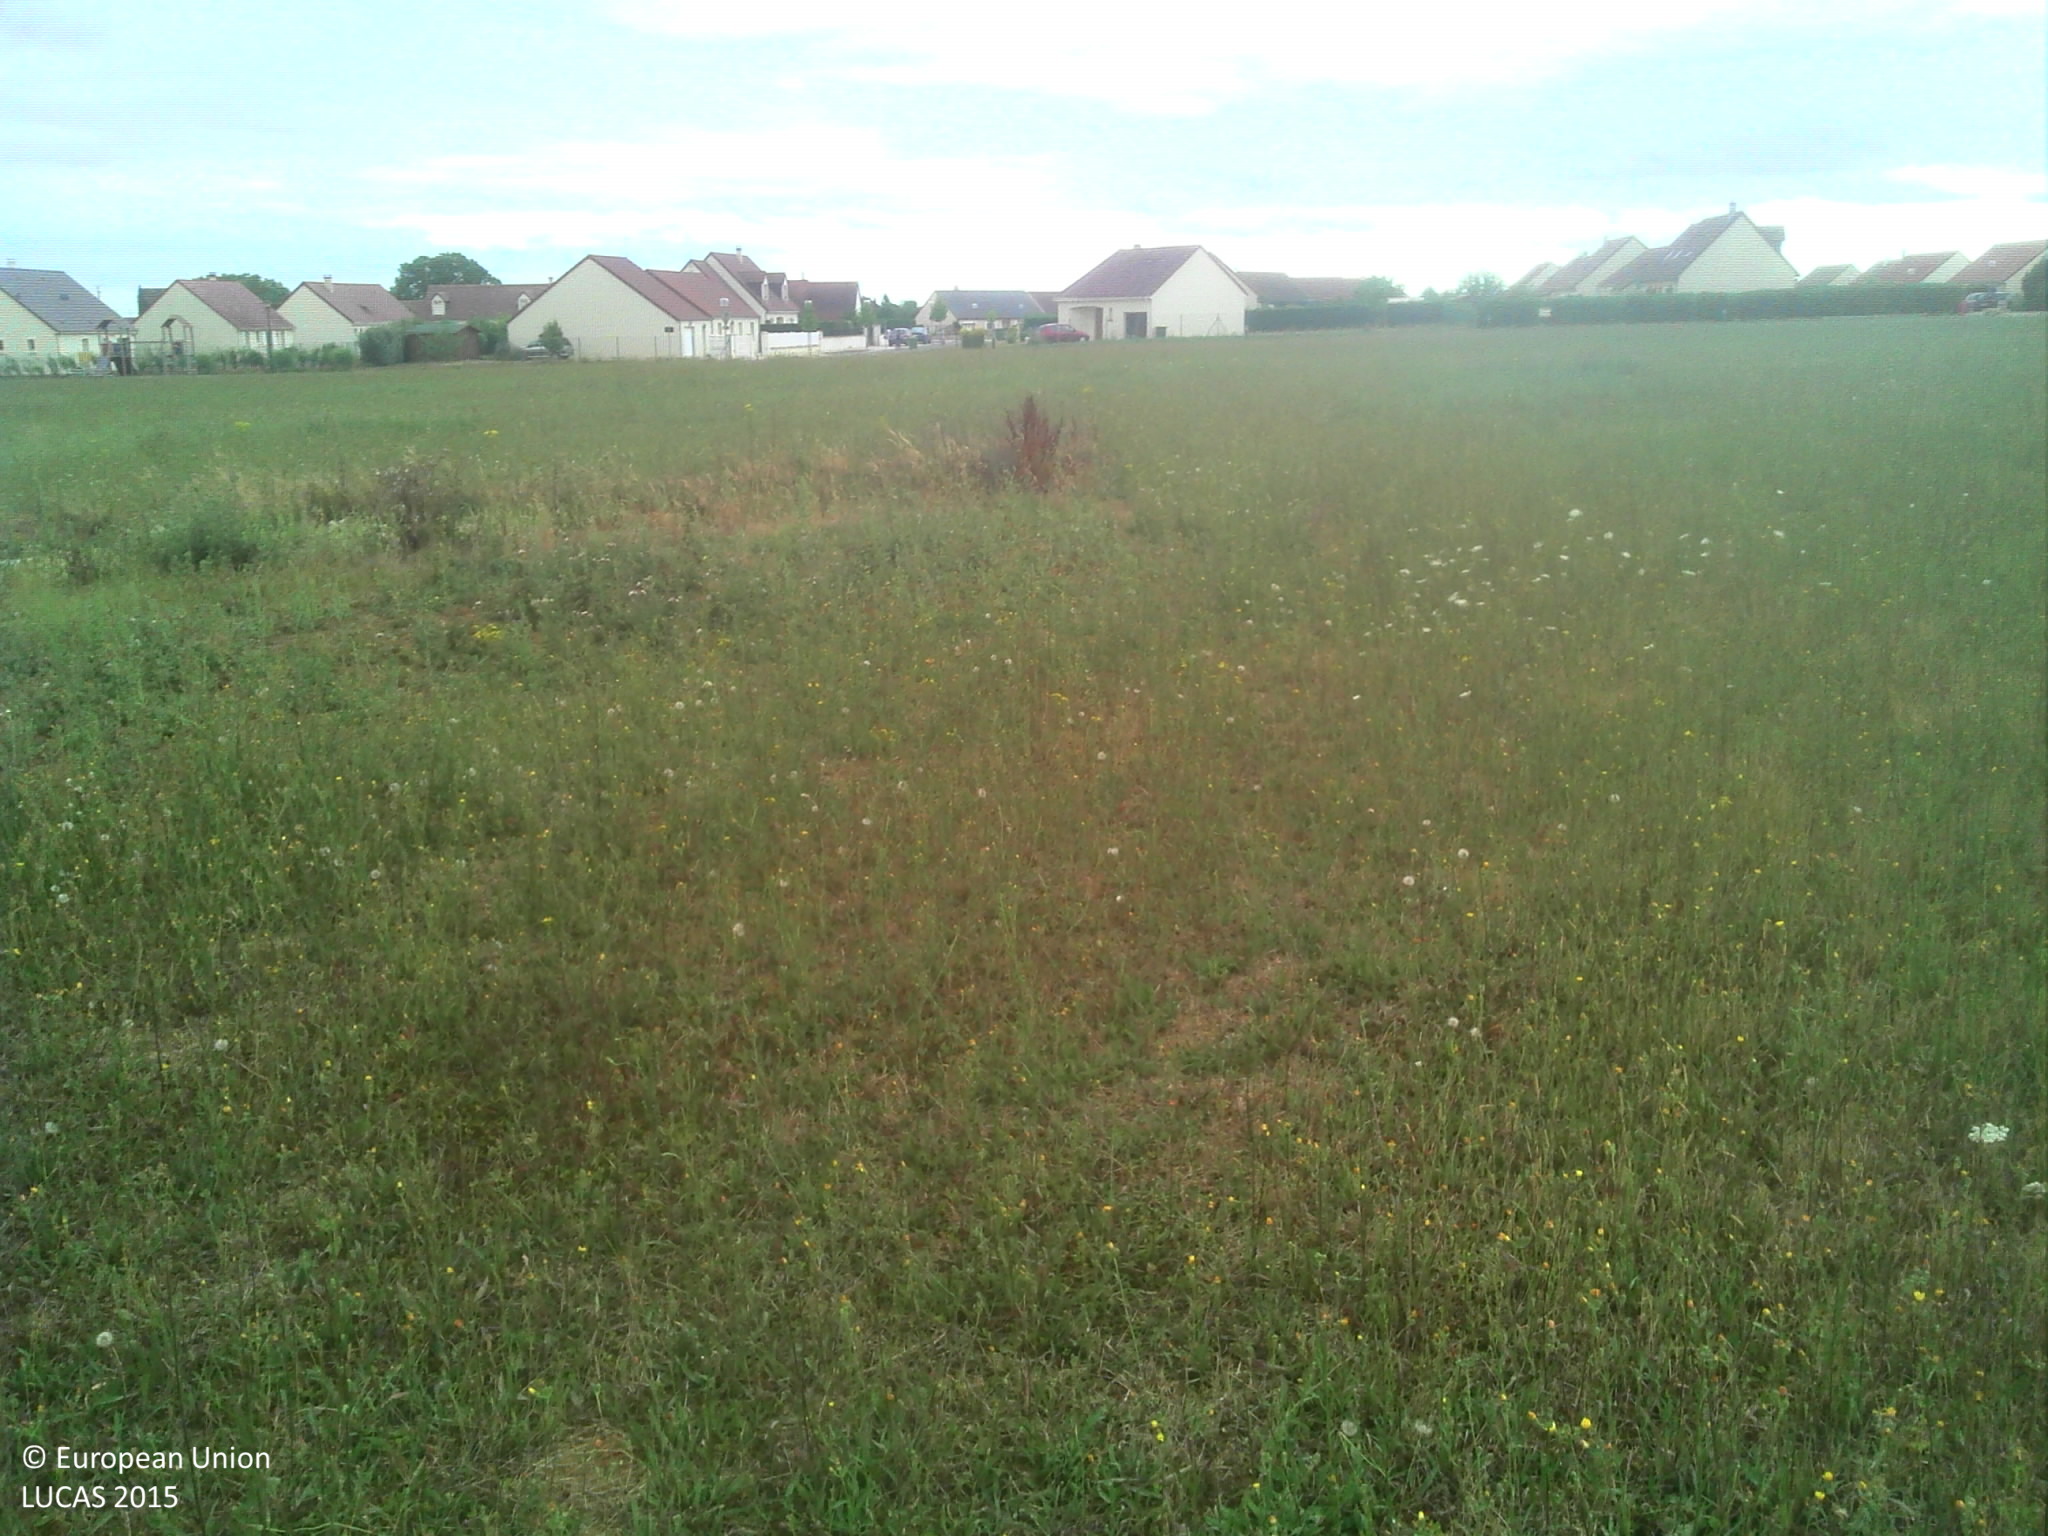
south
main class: Grassland
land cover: Grassland without tree/shrub cover
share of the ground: > 75 %
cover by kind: herbaceous plants 100 %
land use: Semi-natural and natural areas not in use
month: July
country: FR
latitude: 47.8238
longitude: 1.2880
